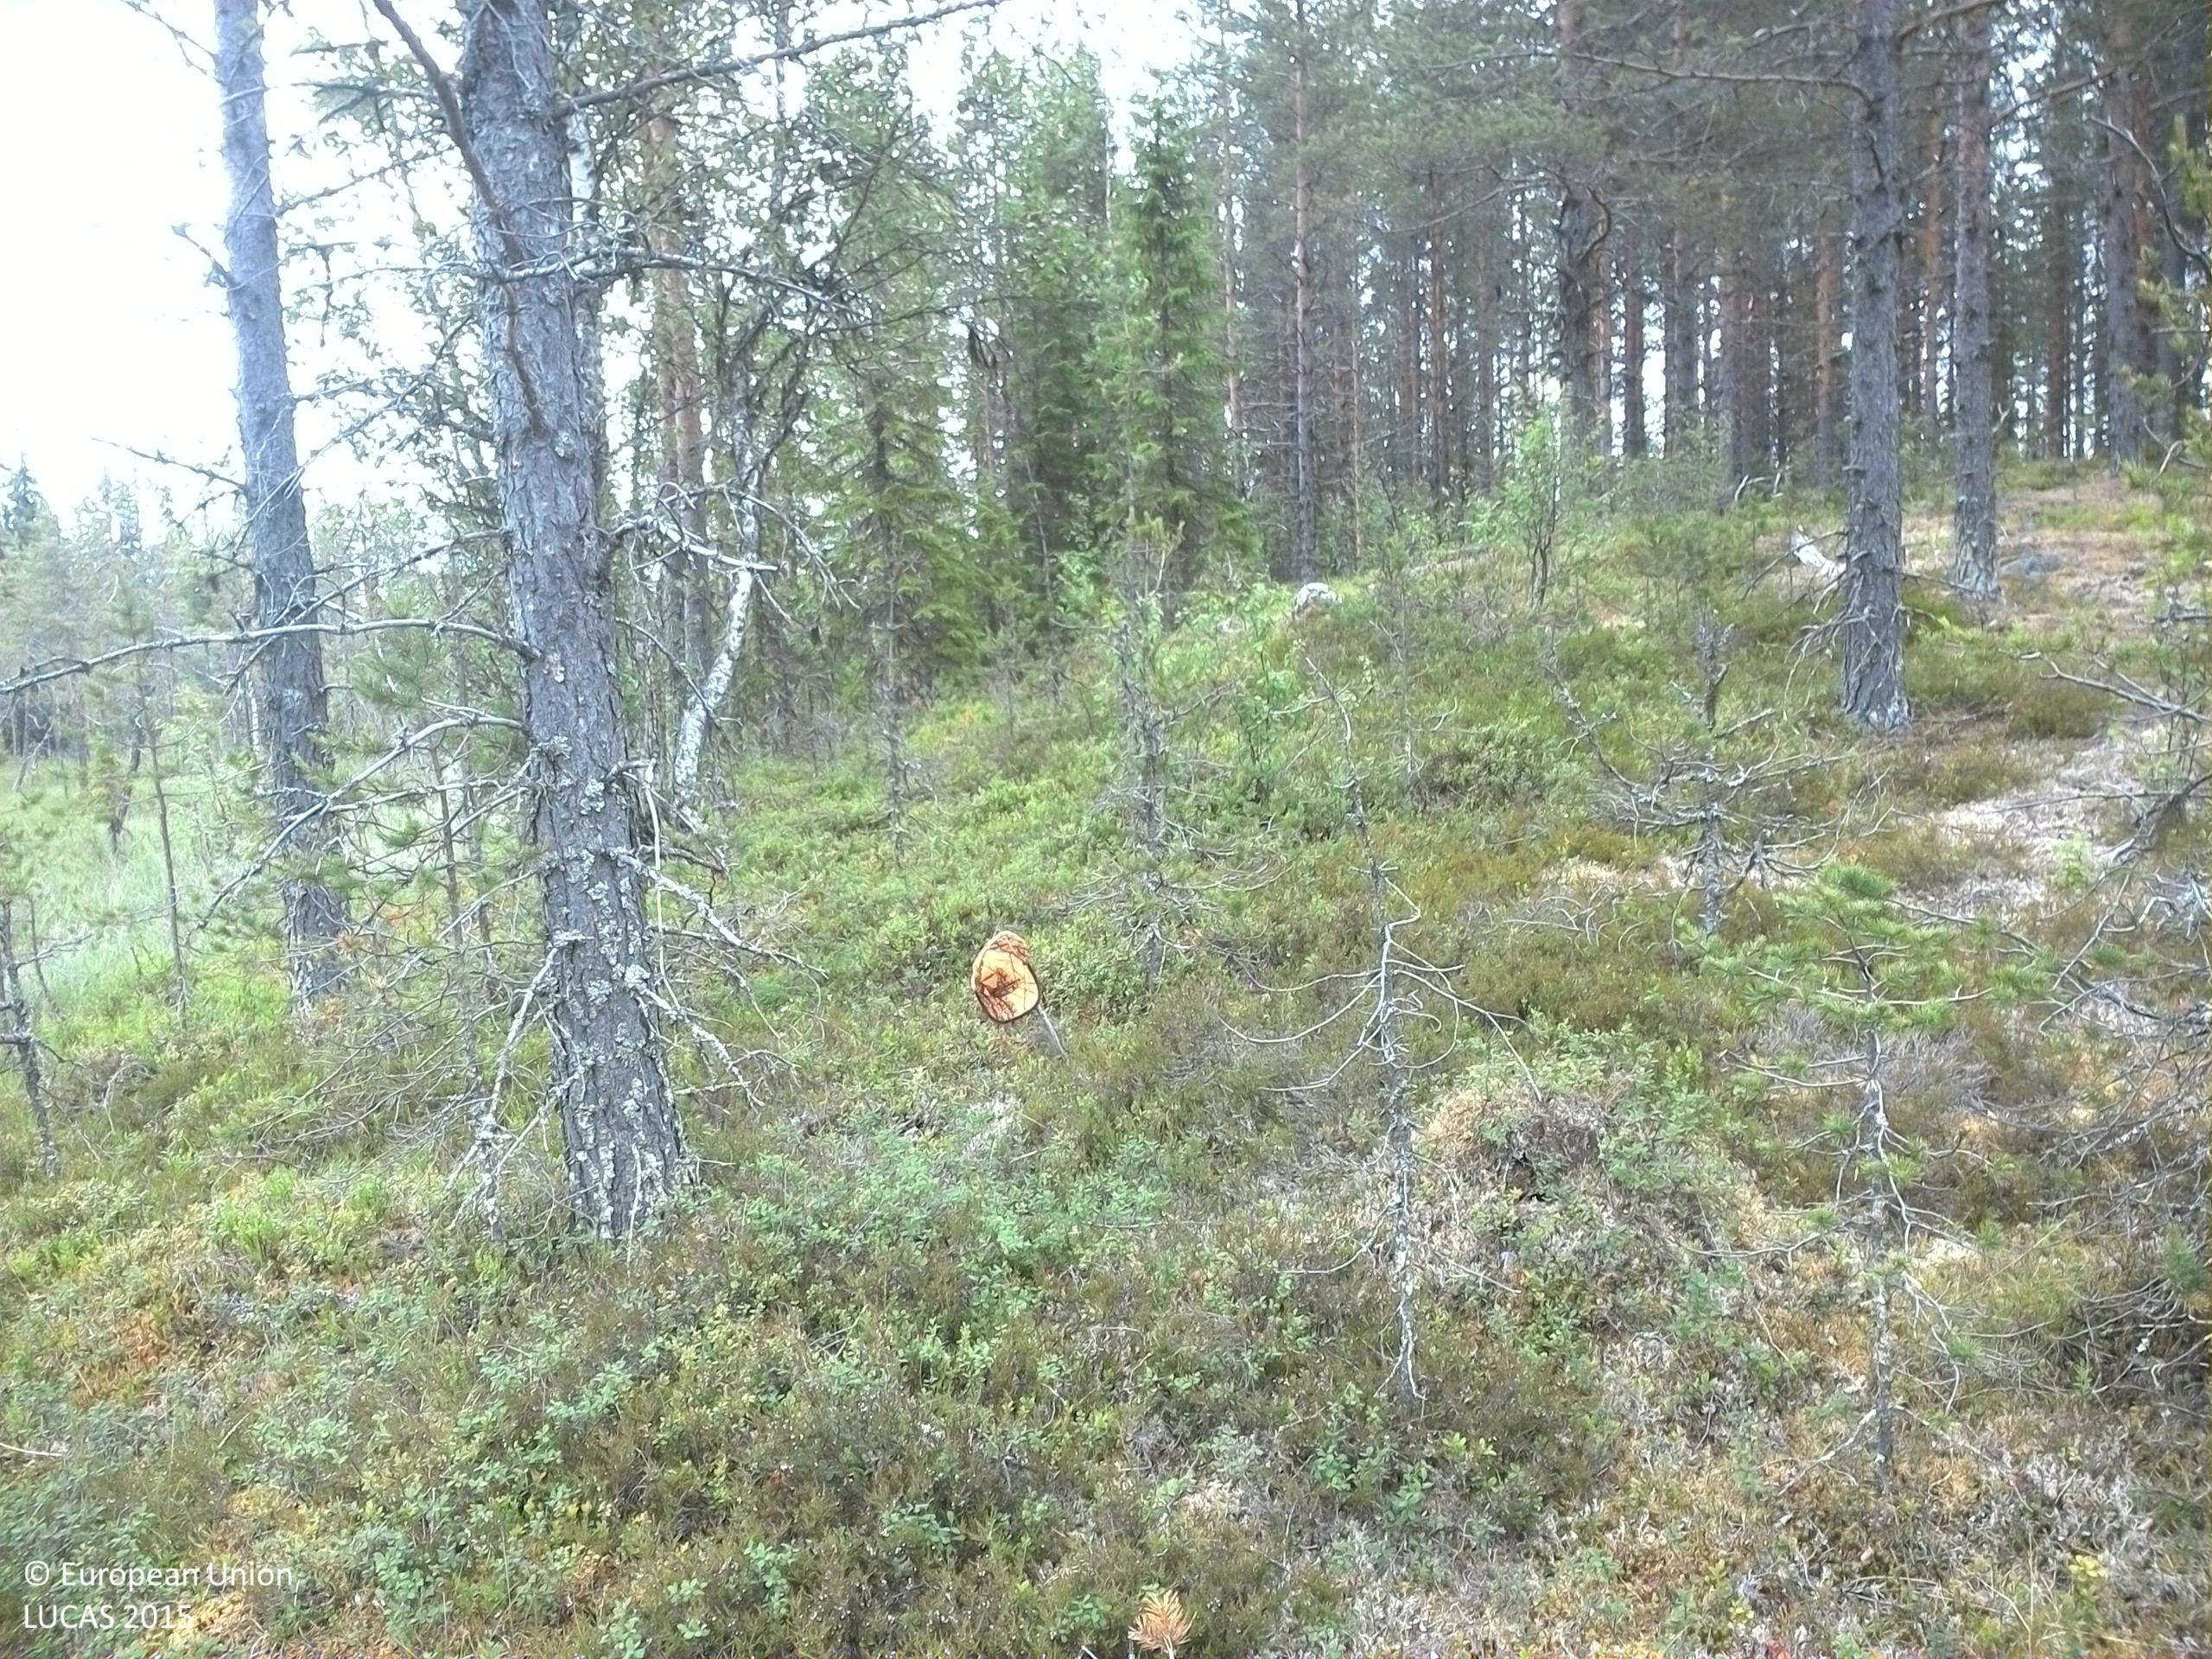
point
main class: Woodland
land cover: Pine dominated coniferous woodland
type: boreal forest
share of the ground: 25 - 50 %
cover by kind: shrubs 50 %, coniferous forest trees 35 %, lichens and mosses 10 %, broadleaved forest trees 5 %
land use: Forestry
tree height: > 5 m
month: July
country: SE
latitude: 63.6080
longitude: 17.4137
